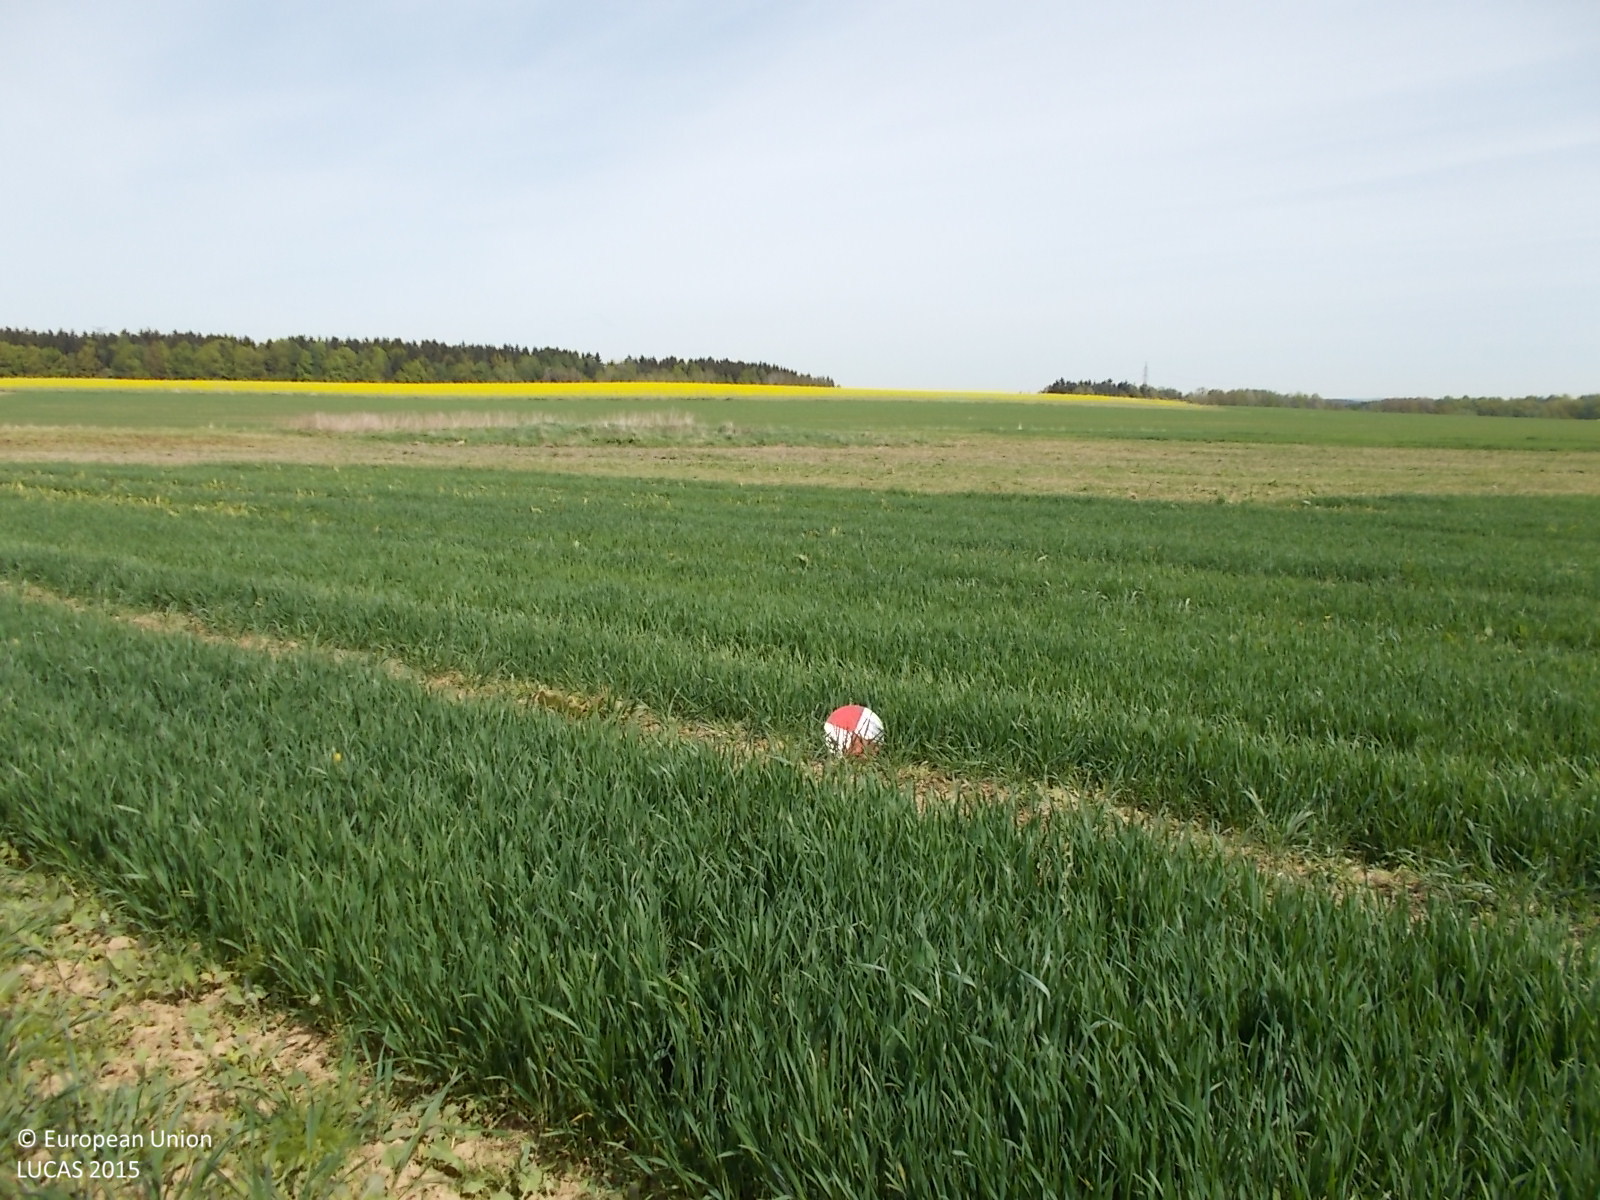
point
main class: Cropland
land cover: Common wheat
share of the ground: > 75 %
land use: Agriculture (excluding fallow land and kitchen gardens)
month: May
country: CZ
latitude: 49.5598
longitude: 15.6031
